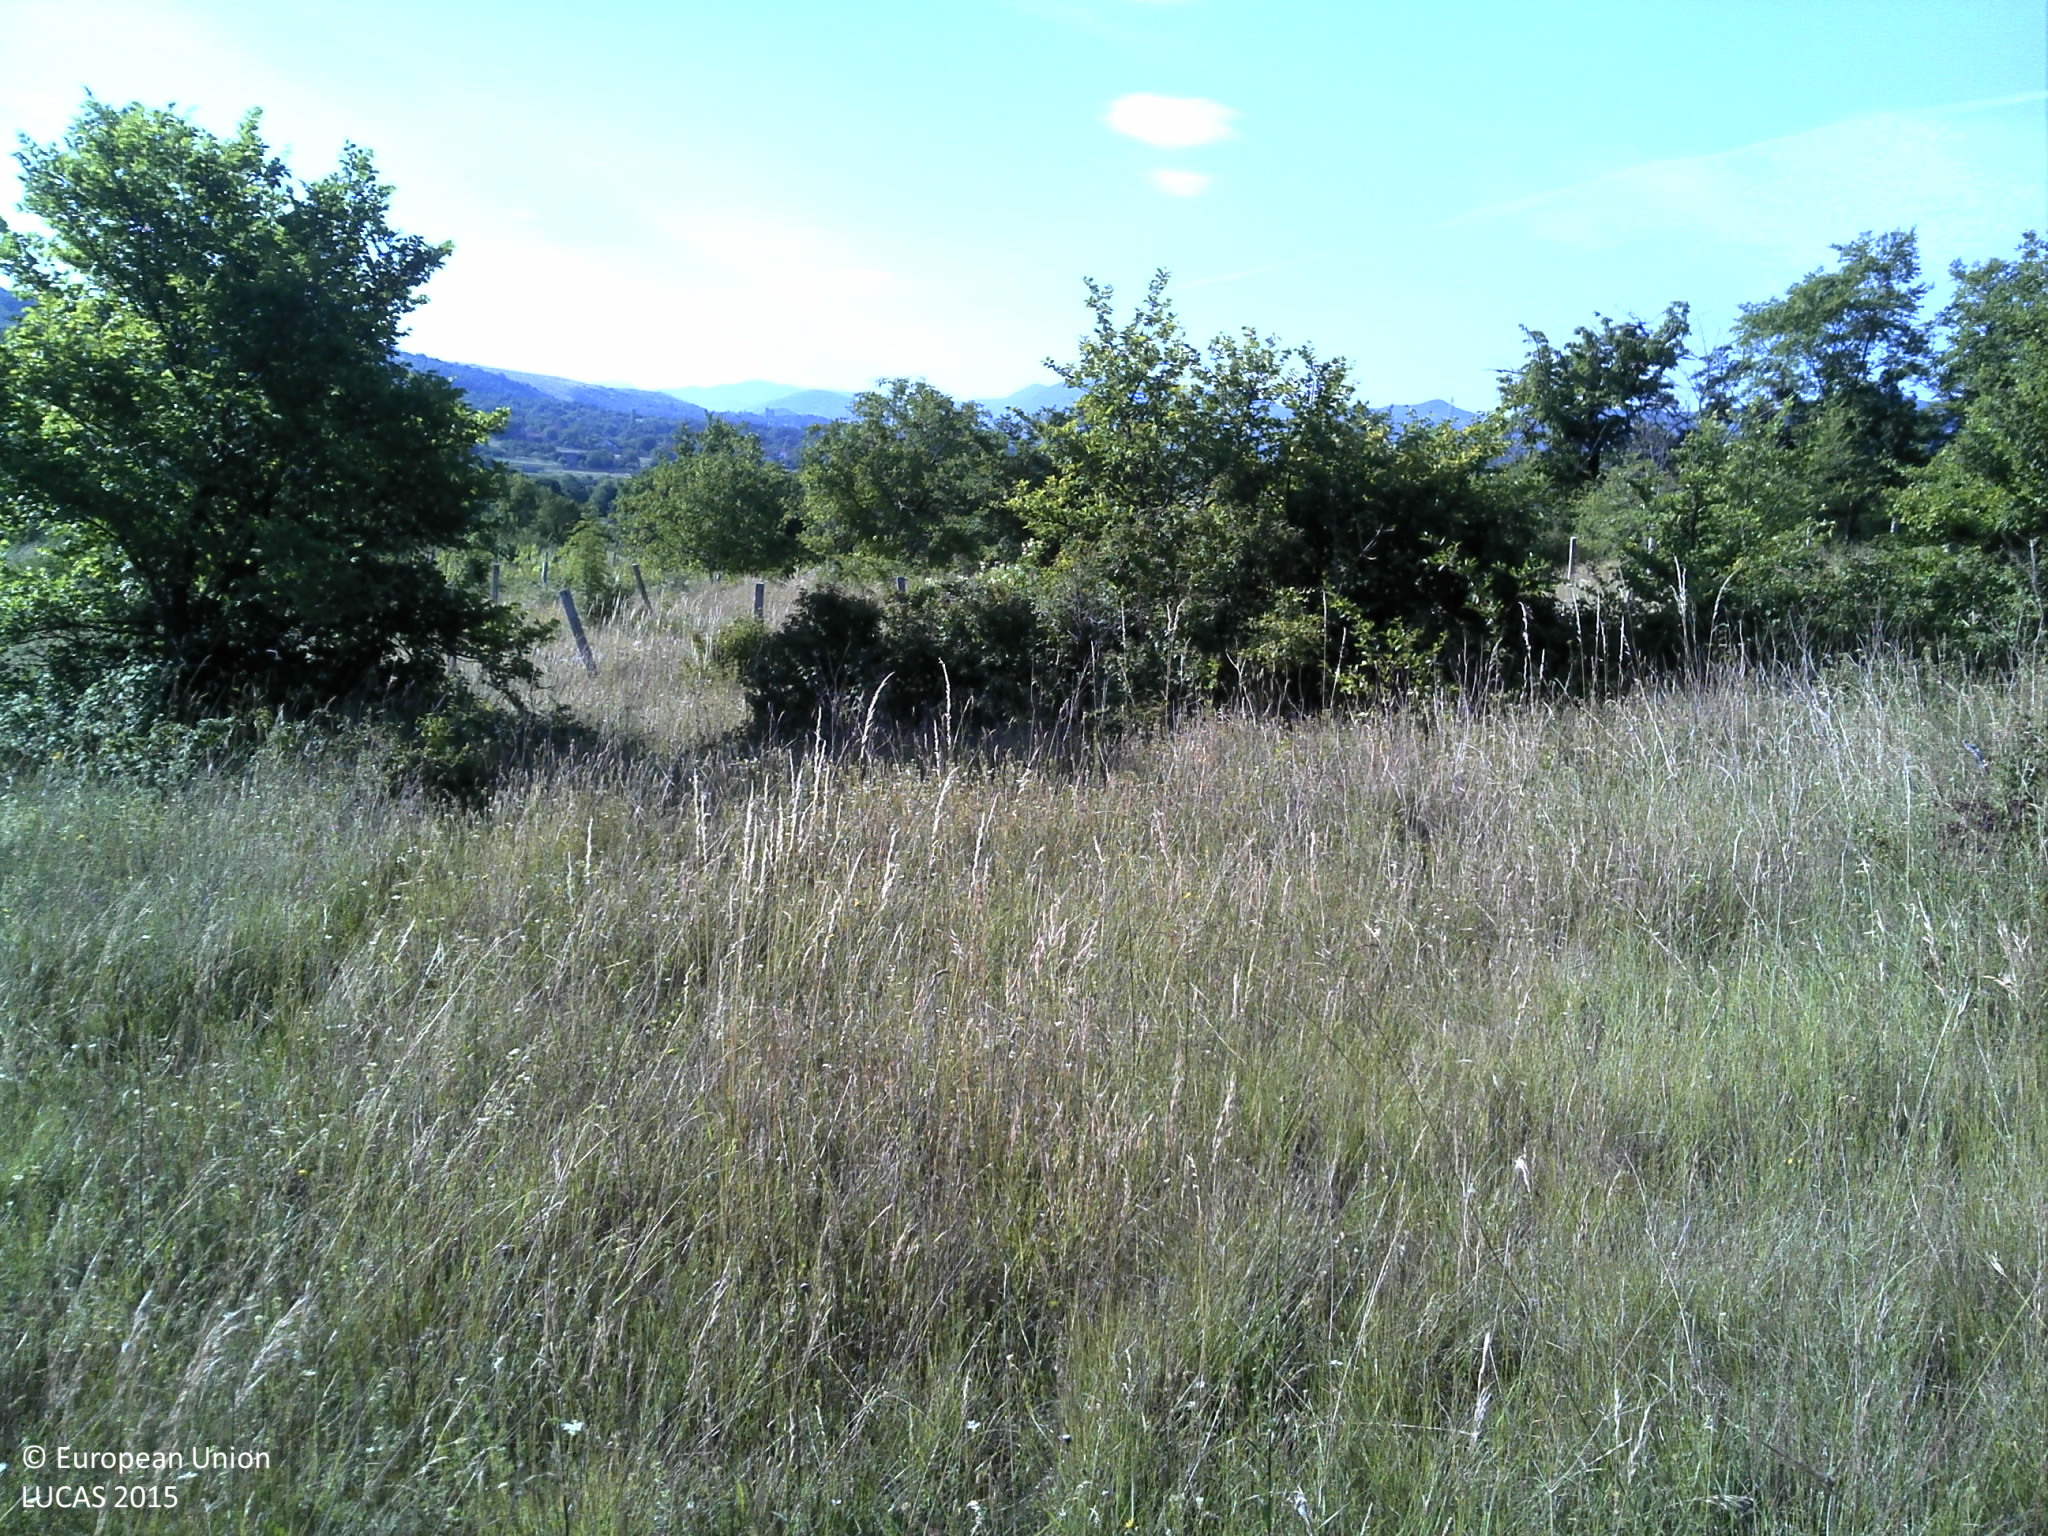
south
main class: Grassland
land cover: Grassland without tree/shrub cover
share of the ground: > 75 %
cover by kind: herbaceous plants 100 %
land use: Agriculture (excluding fallow land and kitchen gardens)
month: July
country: HR
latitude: 43.8546
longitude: 16.2495
